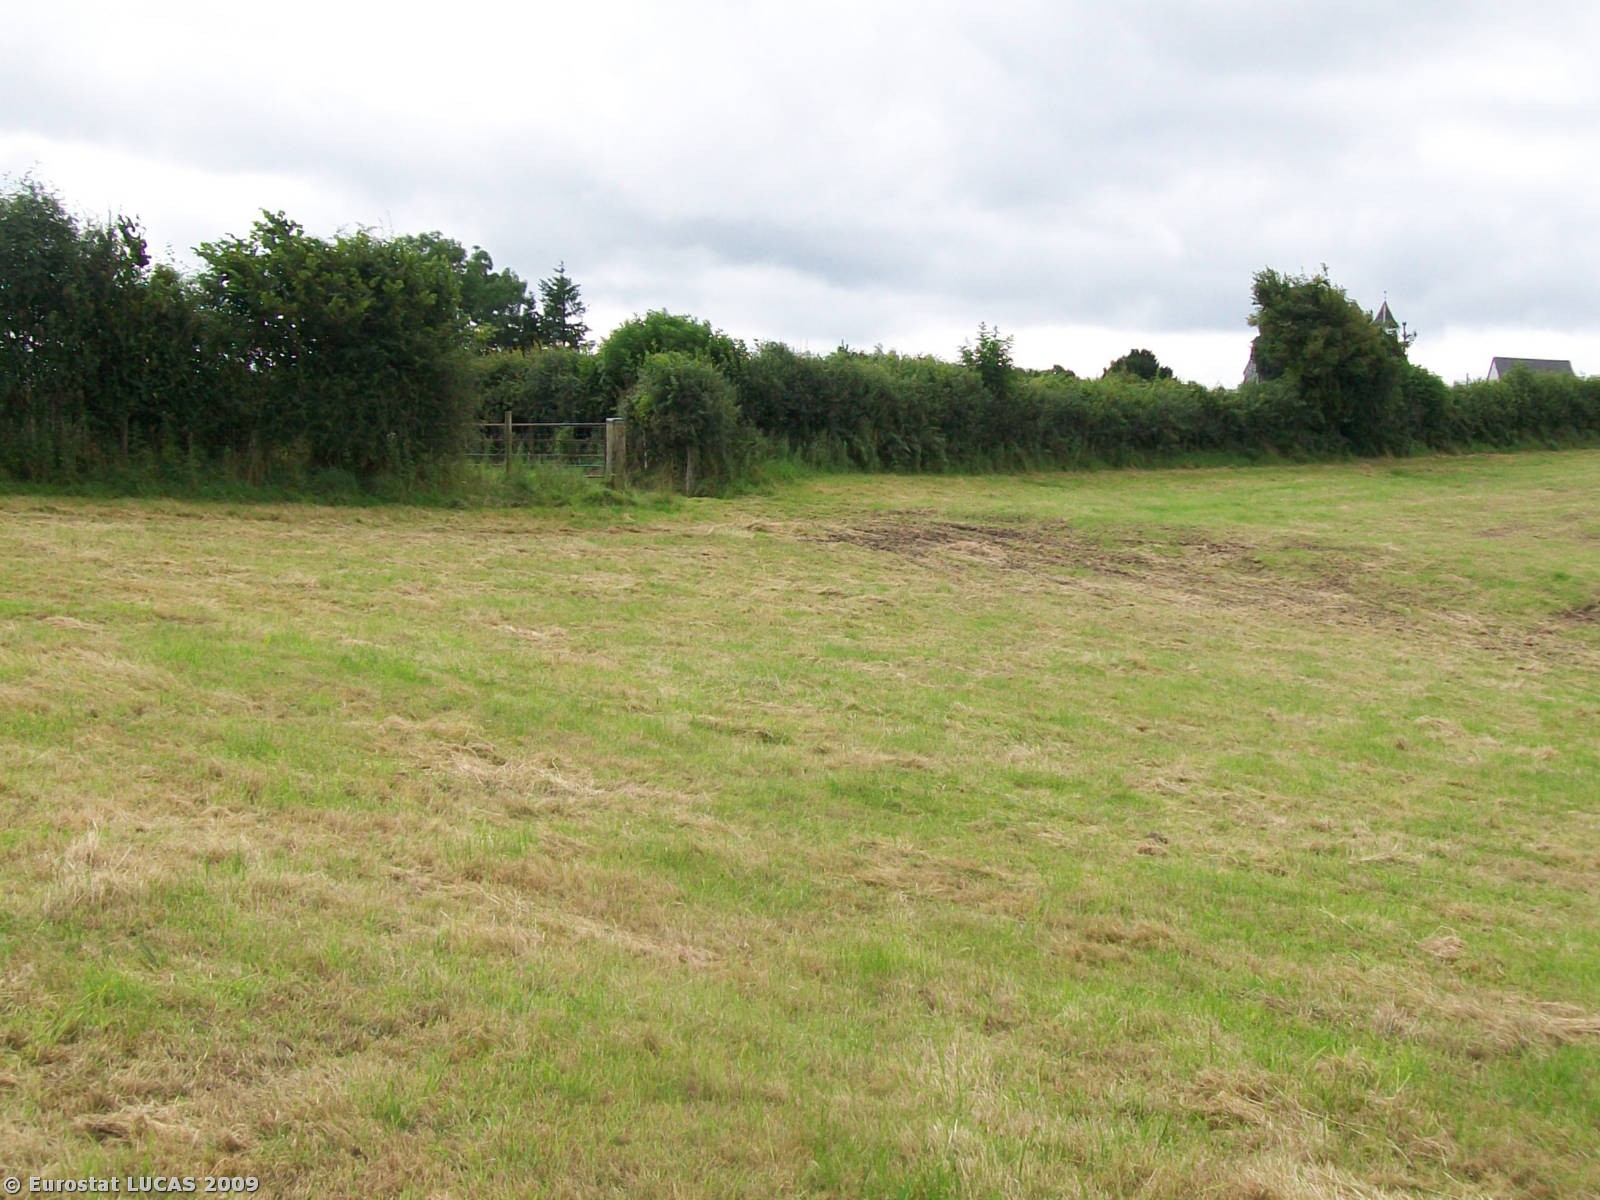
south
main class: Grassland
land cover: Grassland without tree/shrub cover
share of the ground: > 75 %
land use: Agriculture (excluding fallow land and kitchen gardens)
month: August
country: GB
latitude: 52.6030
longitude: -3.3556
